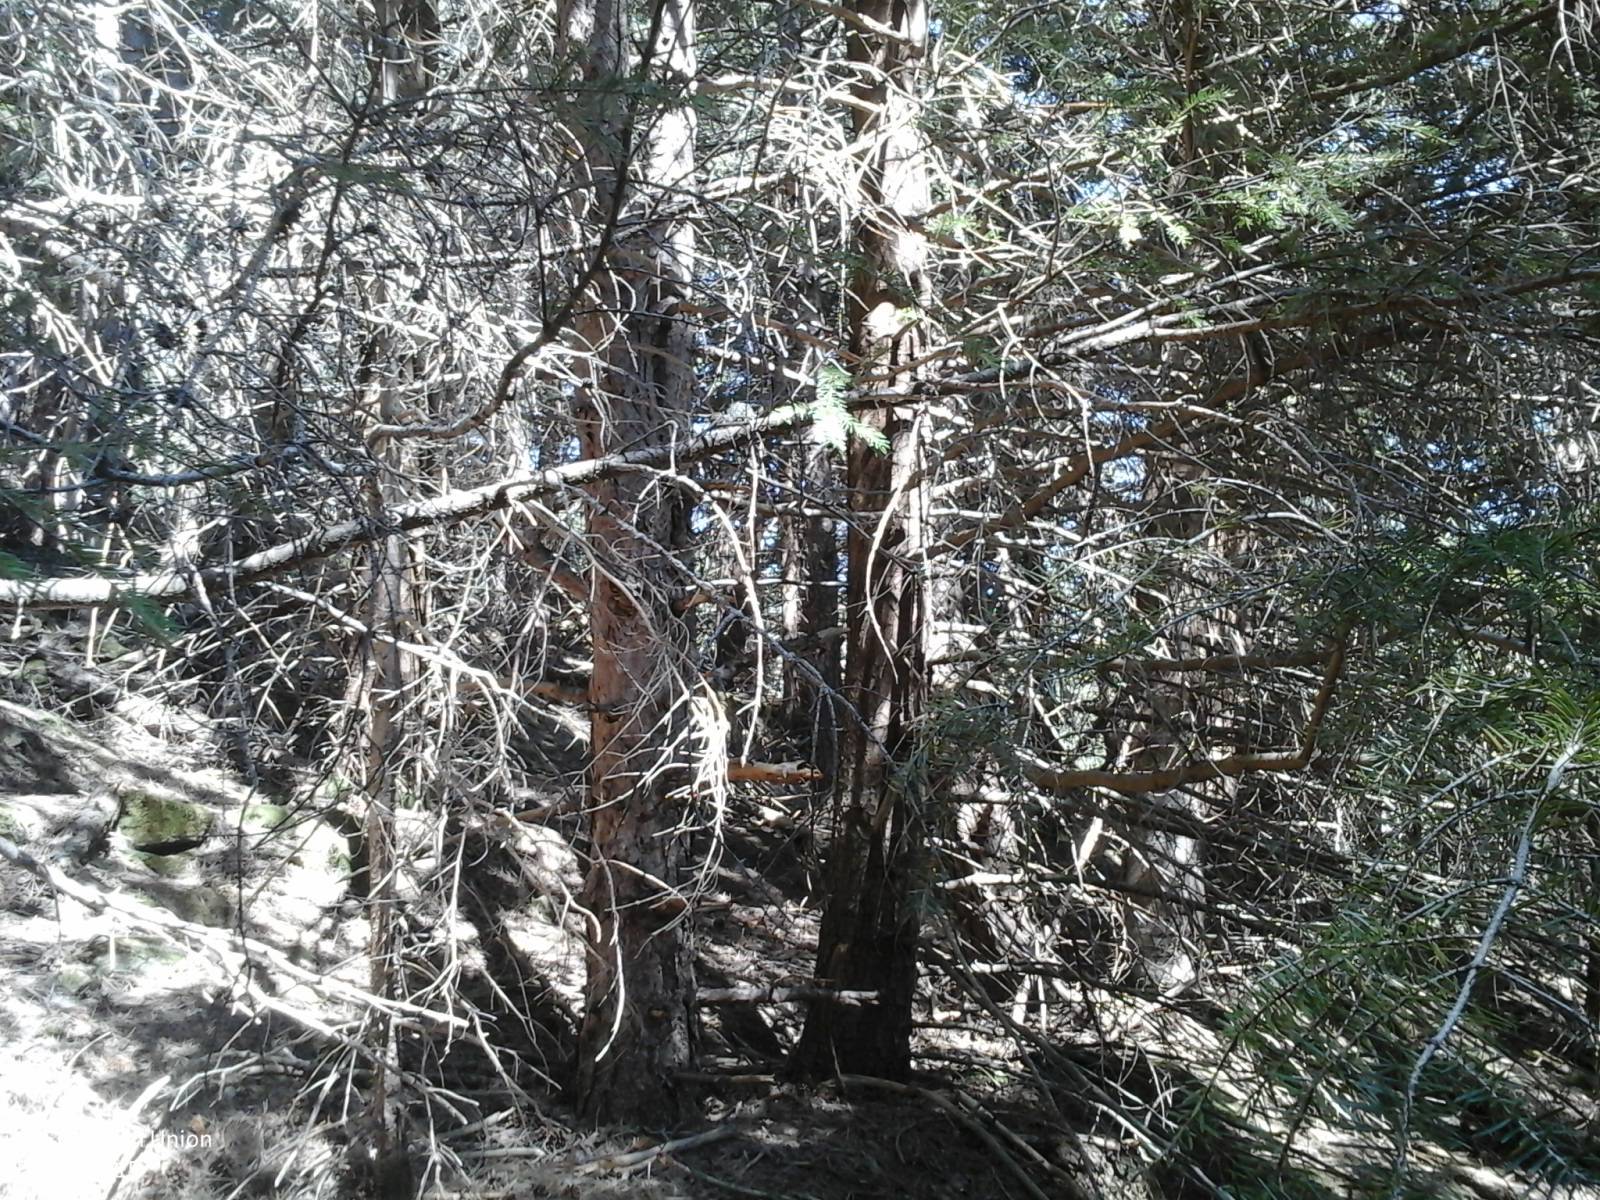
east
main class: Woodland
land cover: Other coniferous woodland
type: coniferous forest of the mediterranean region
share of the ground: > 75 %
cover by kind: coniferous forest trees 100 %
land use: Forestry
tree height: > 5 m
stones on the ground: 10 - 25 %
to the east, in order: Other coniferous woodland; Pine dominated coniferous woodland
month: July
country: IT
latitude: 42.5644
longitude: 13.2909
